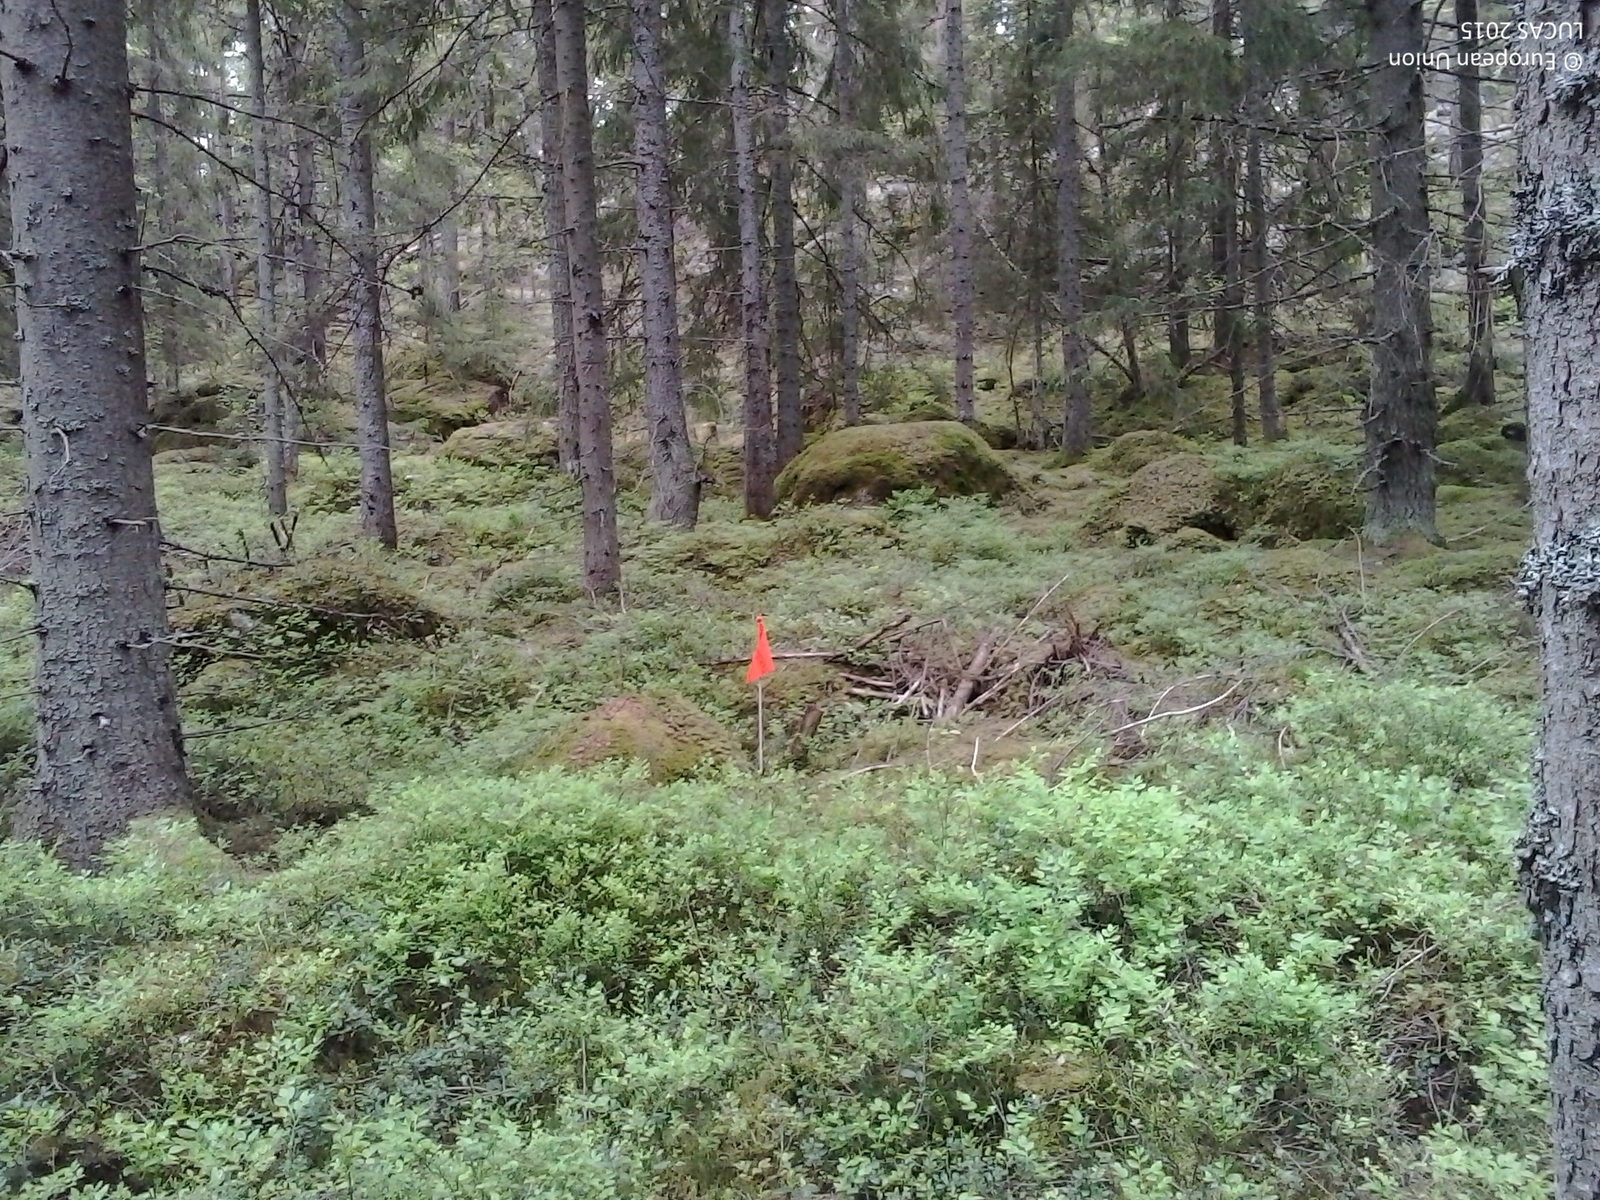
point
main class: Woodland
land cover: Spruce dominated coniferous woodland
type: boreal forest
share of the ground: 50 - 75 %
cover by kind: coniferous forest trees 55 %, broadleaved forest trees 15 %, shrubs 10 %, herbaceous plants 10 %, lichens and mosses 10 %
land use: Forestry
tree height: > 5 m
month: June
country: SE
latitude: 59.3644
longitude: 14.0909
